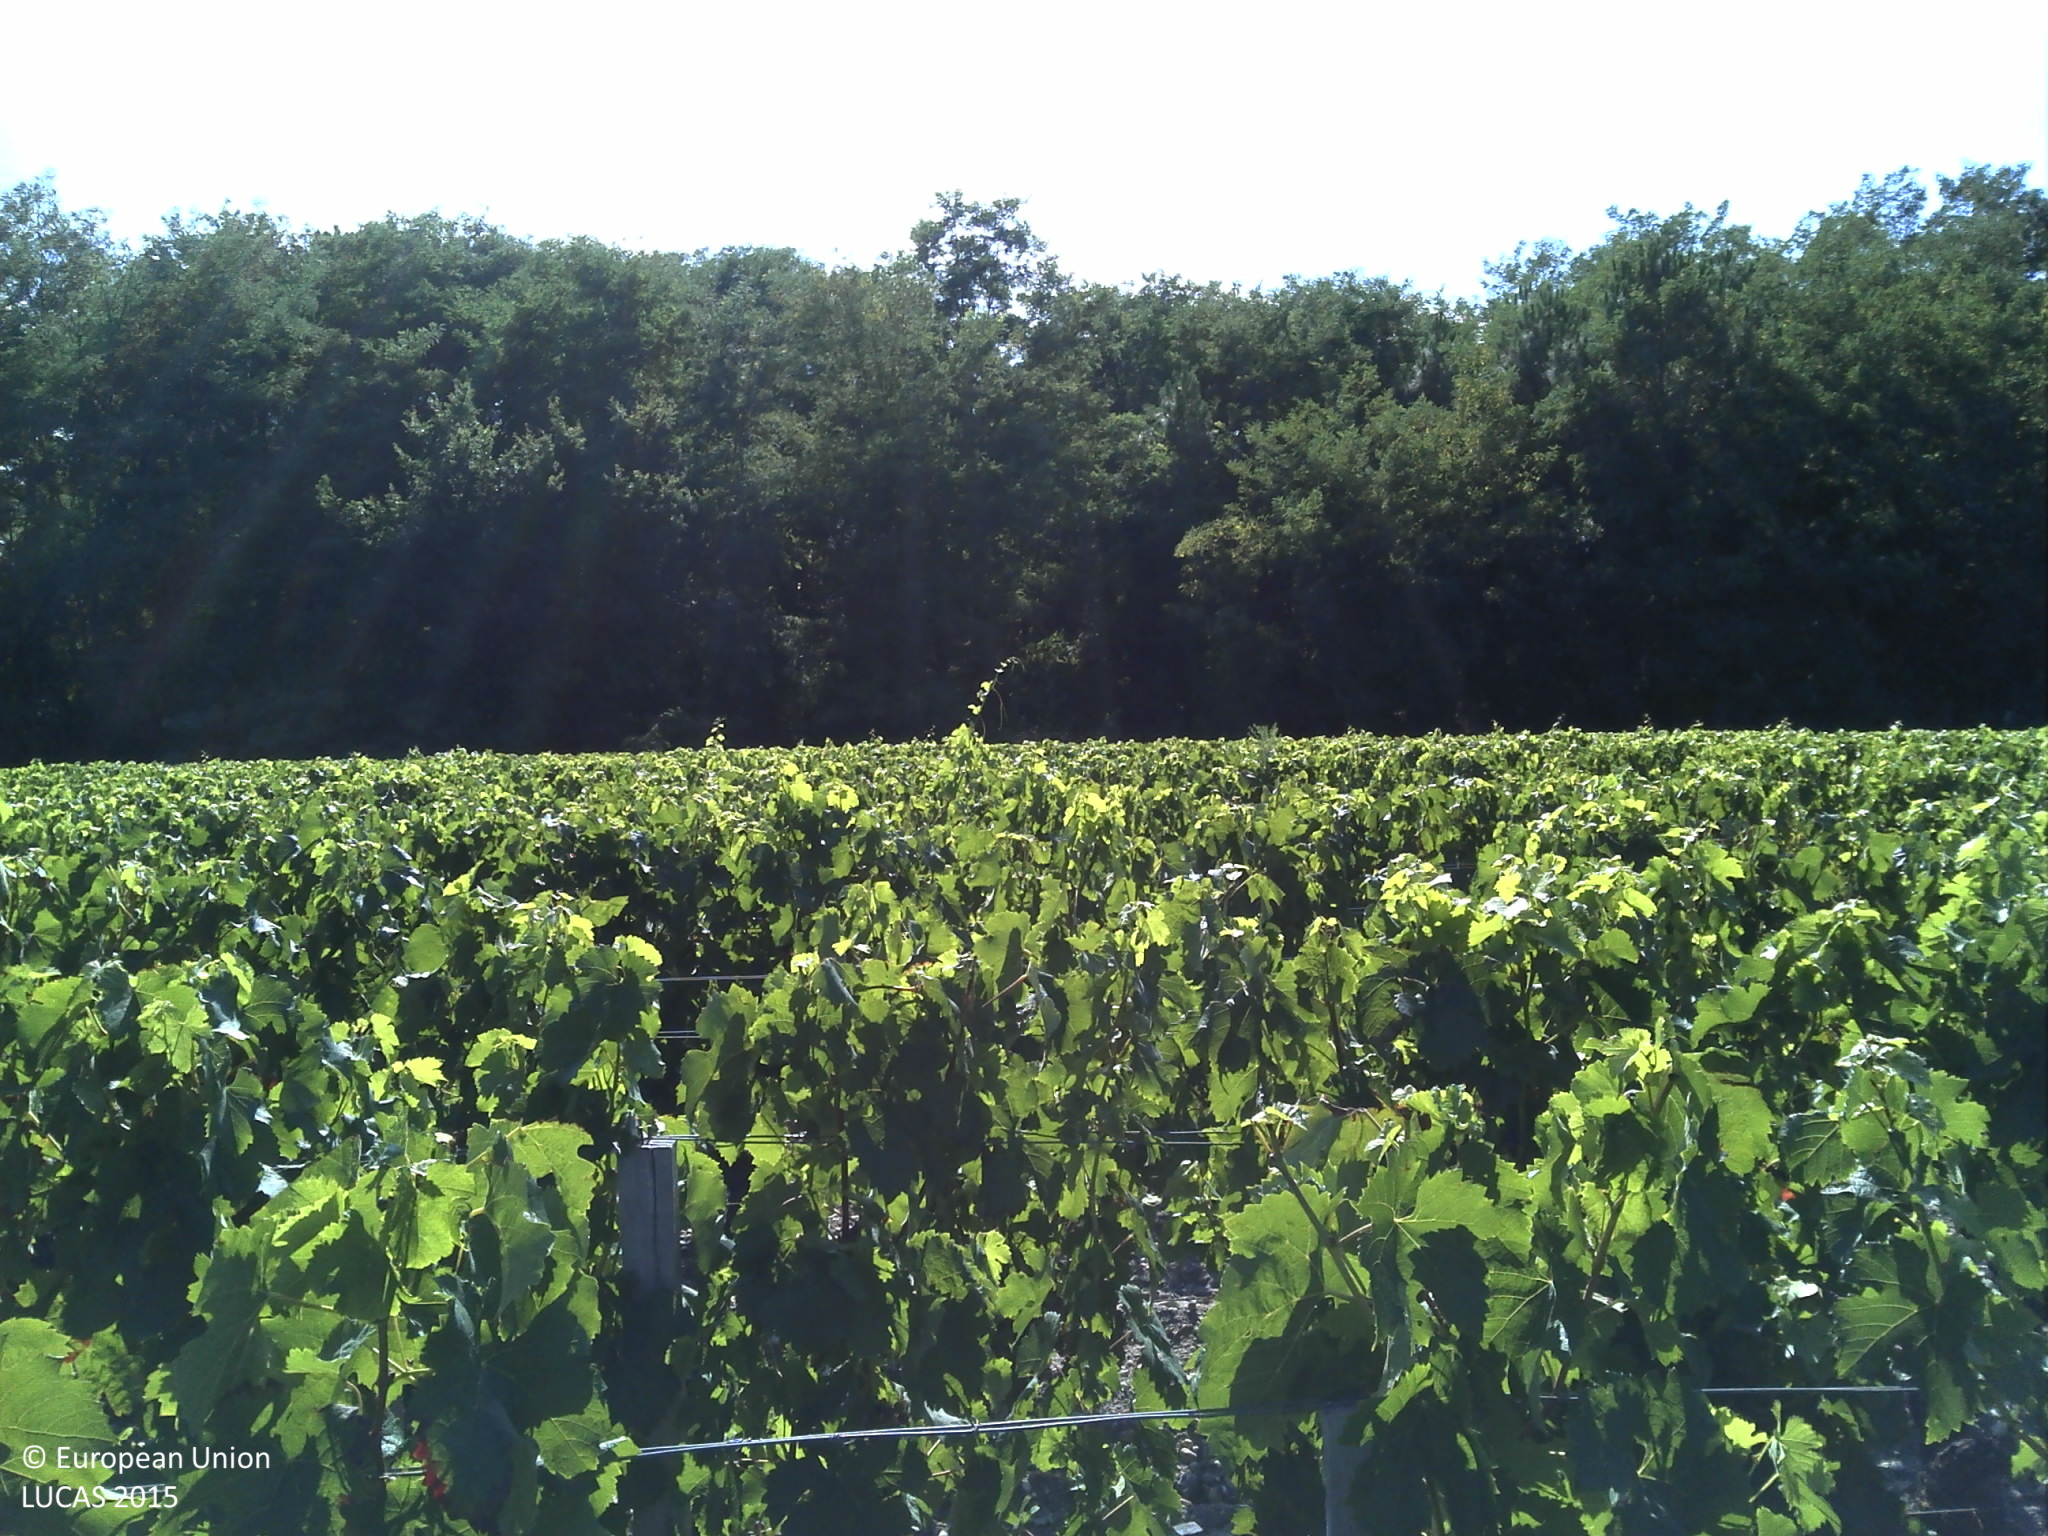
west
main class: Cropland
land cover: Vineyards
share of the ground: 25 - 50 %
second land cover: Other bare soil
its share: > 75 %
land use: Agriculture (excluding fallow land and kitchen gardens)
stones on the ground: 25 - 50 %
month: August
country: FR
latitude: 45.0804
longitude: -0.7563
